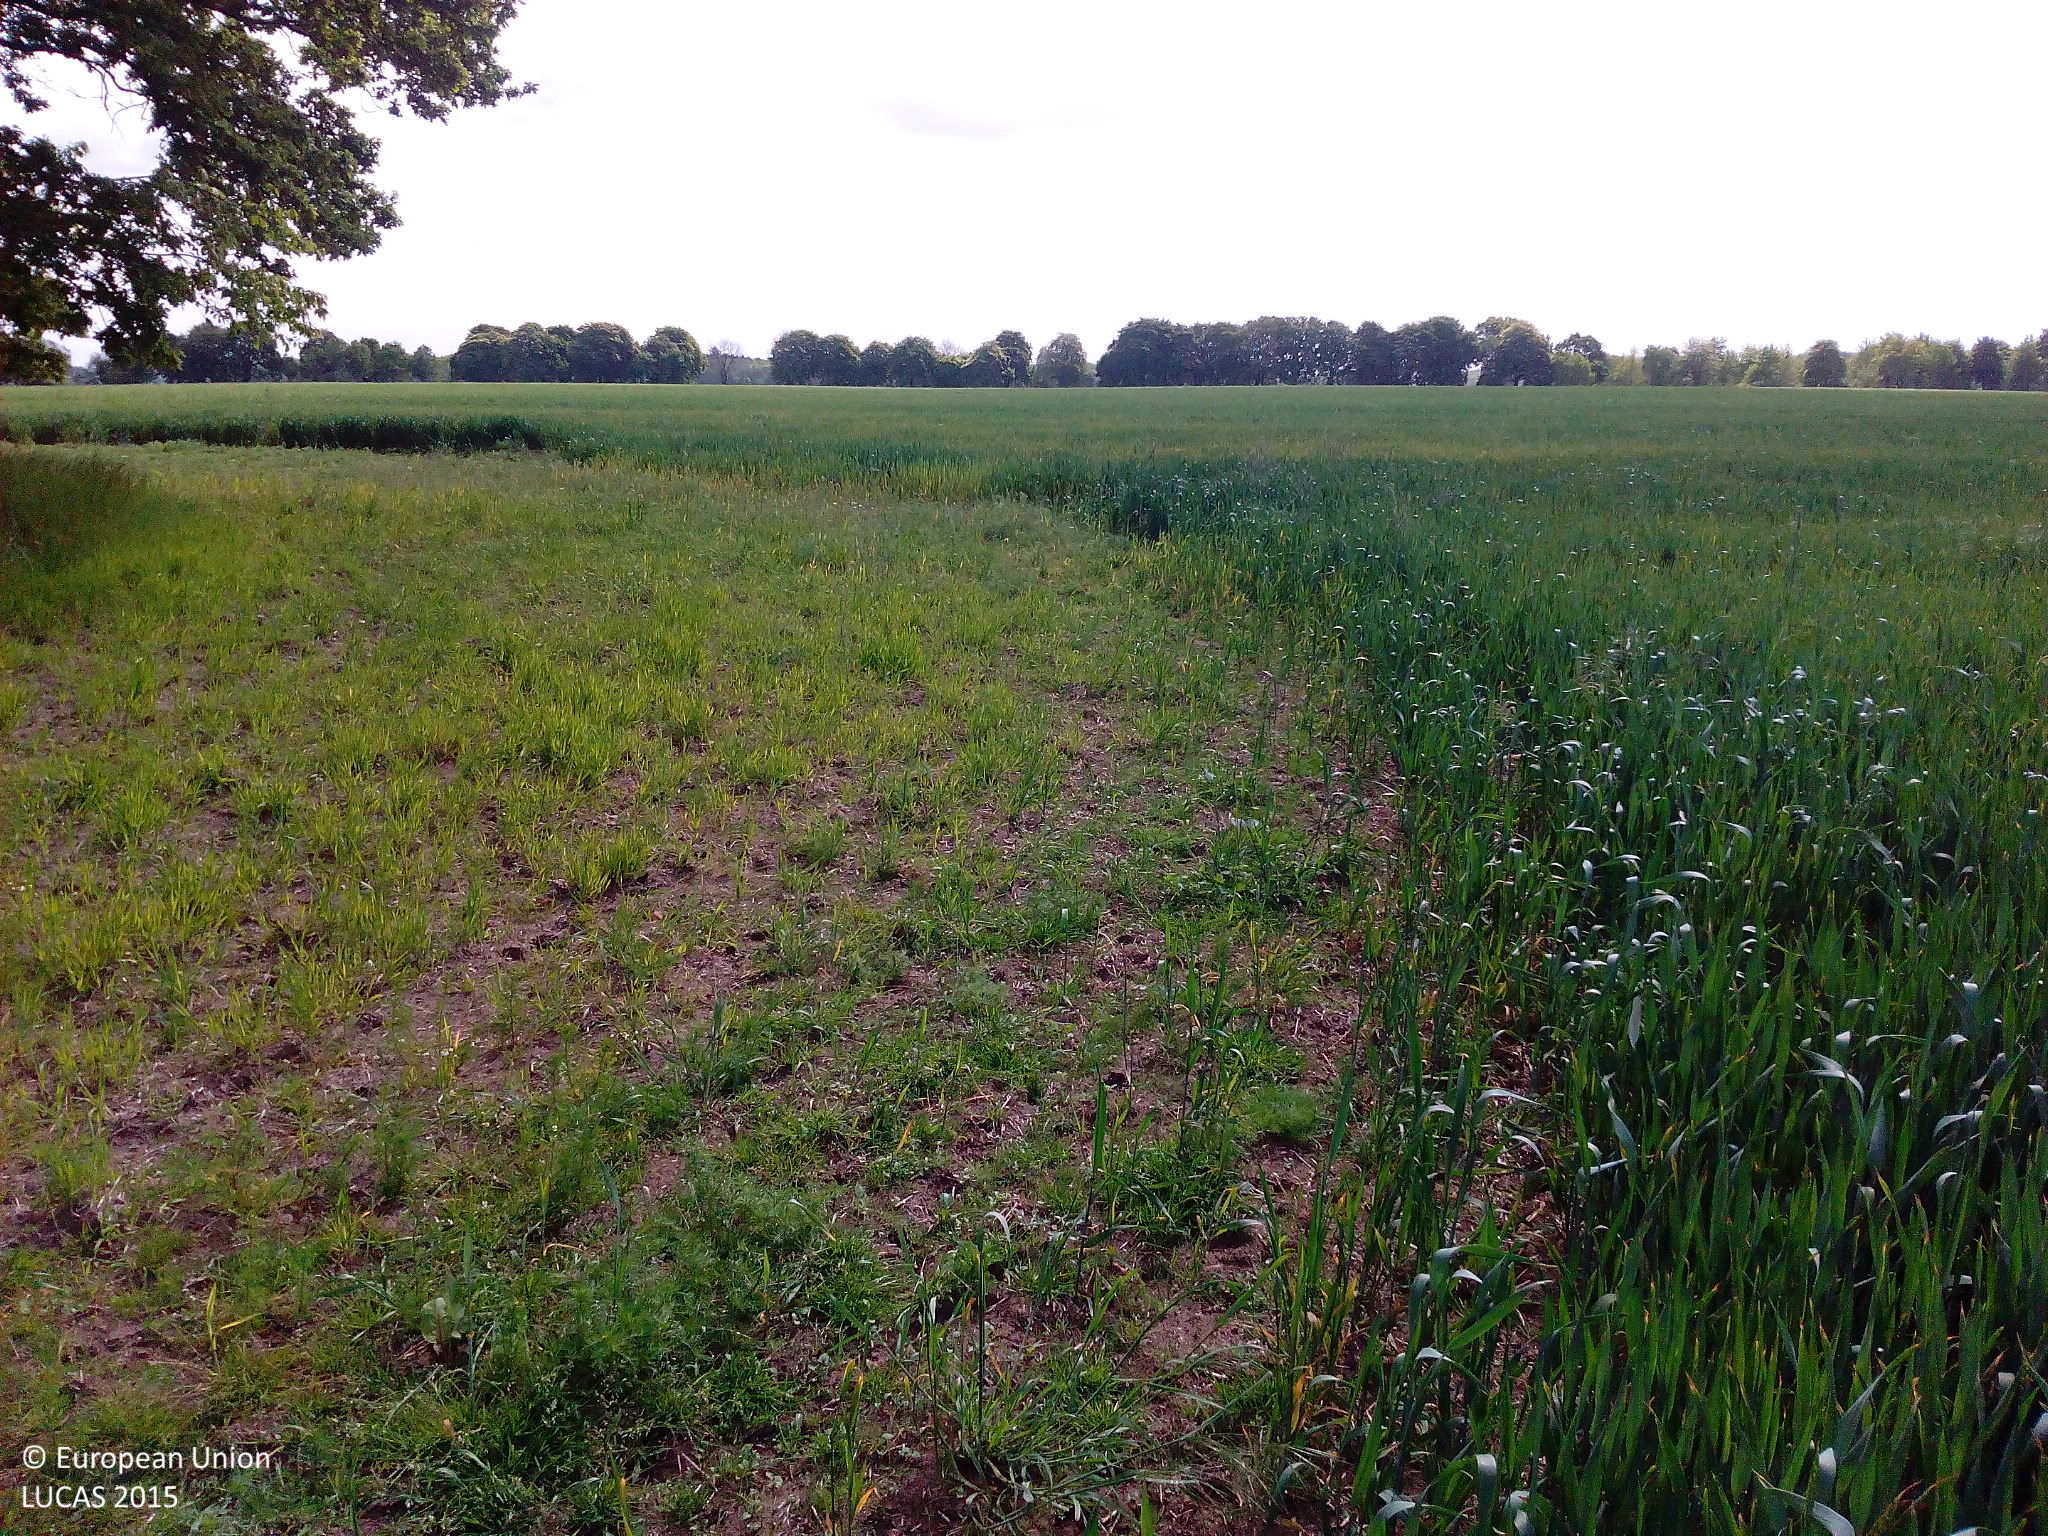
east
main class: Cropland
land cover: Rye
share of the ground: > 75 %
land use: Agriculture (excluding fallow land and kitchen gardens)
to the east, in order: Rye; Spontaneously vegetated surfaces; Rye
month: June
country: DE
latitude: 54.4180
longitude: 13.3124
